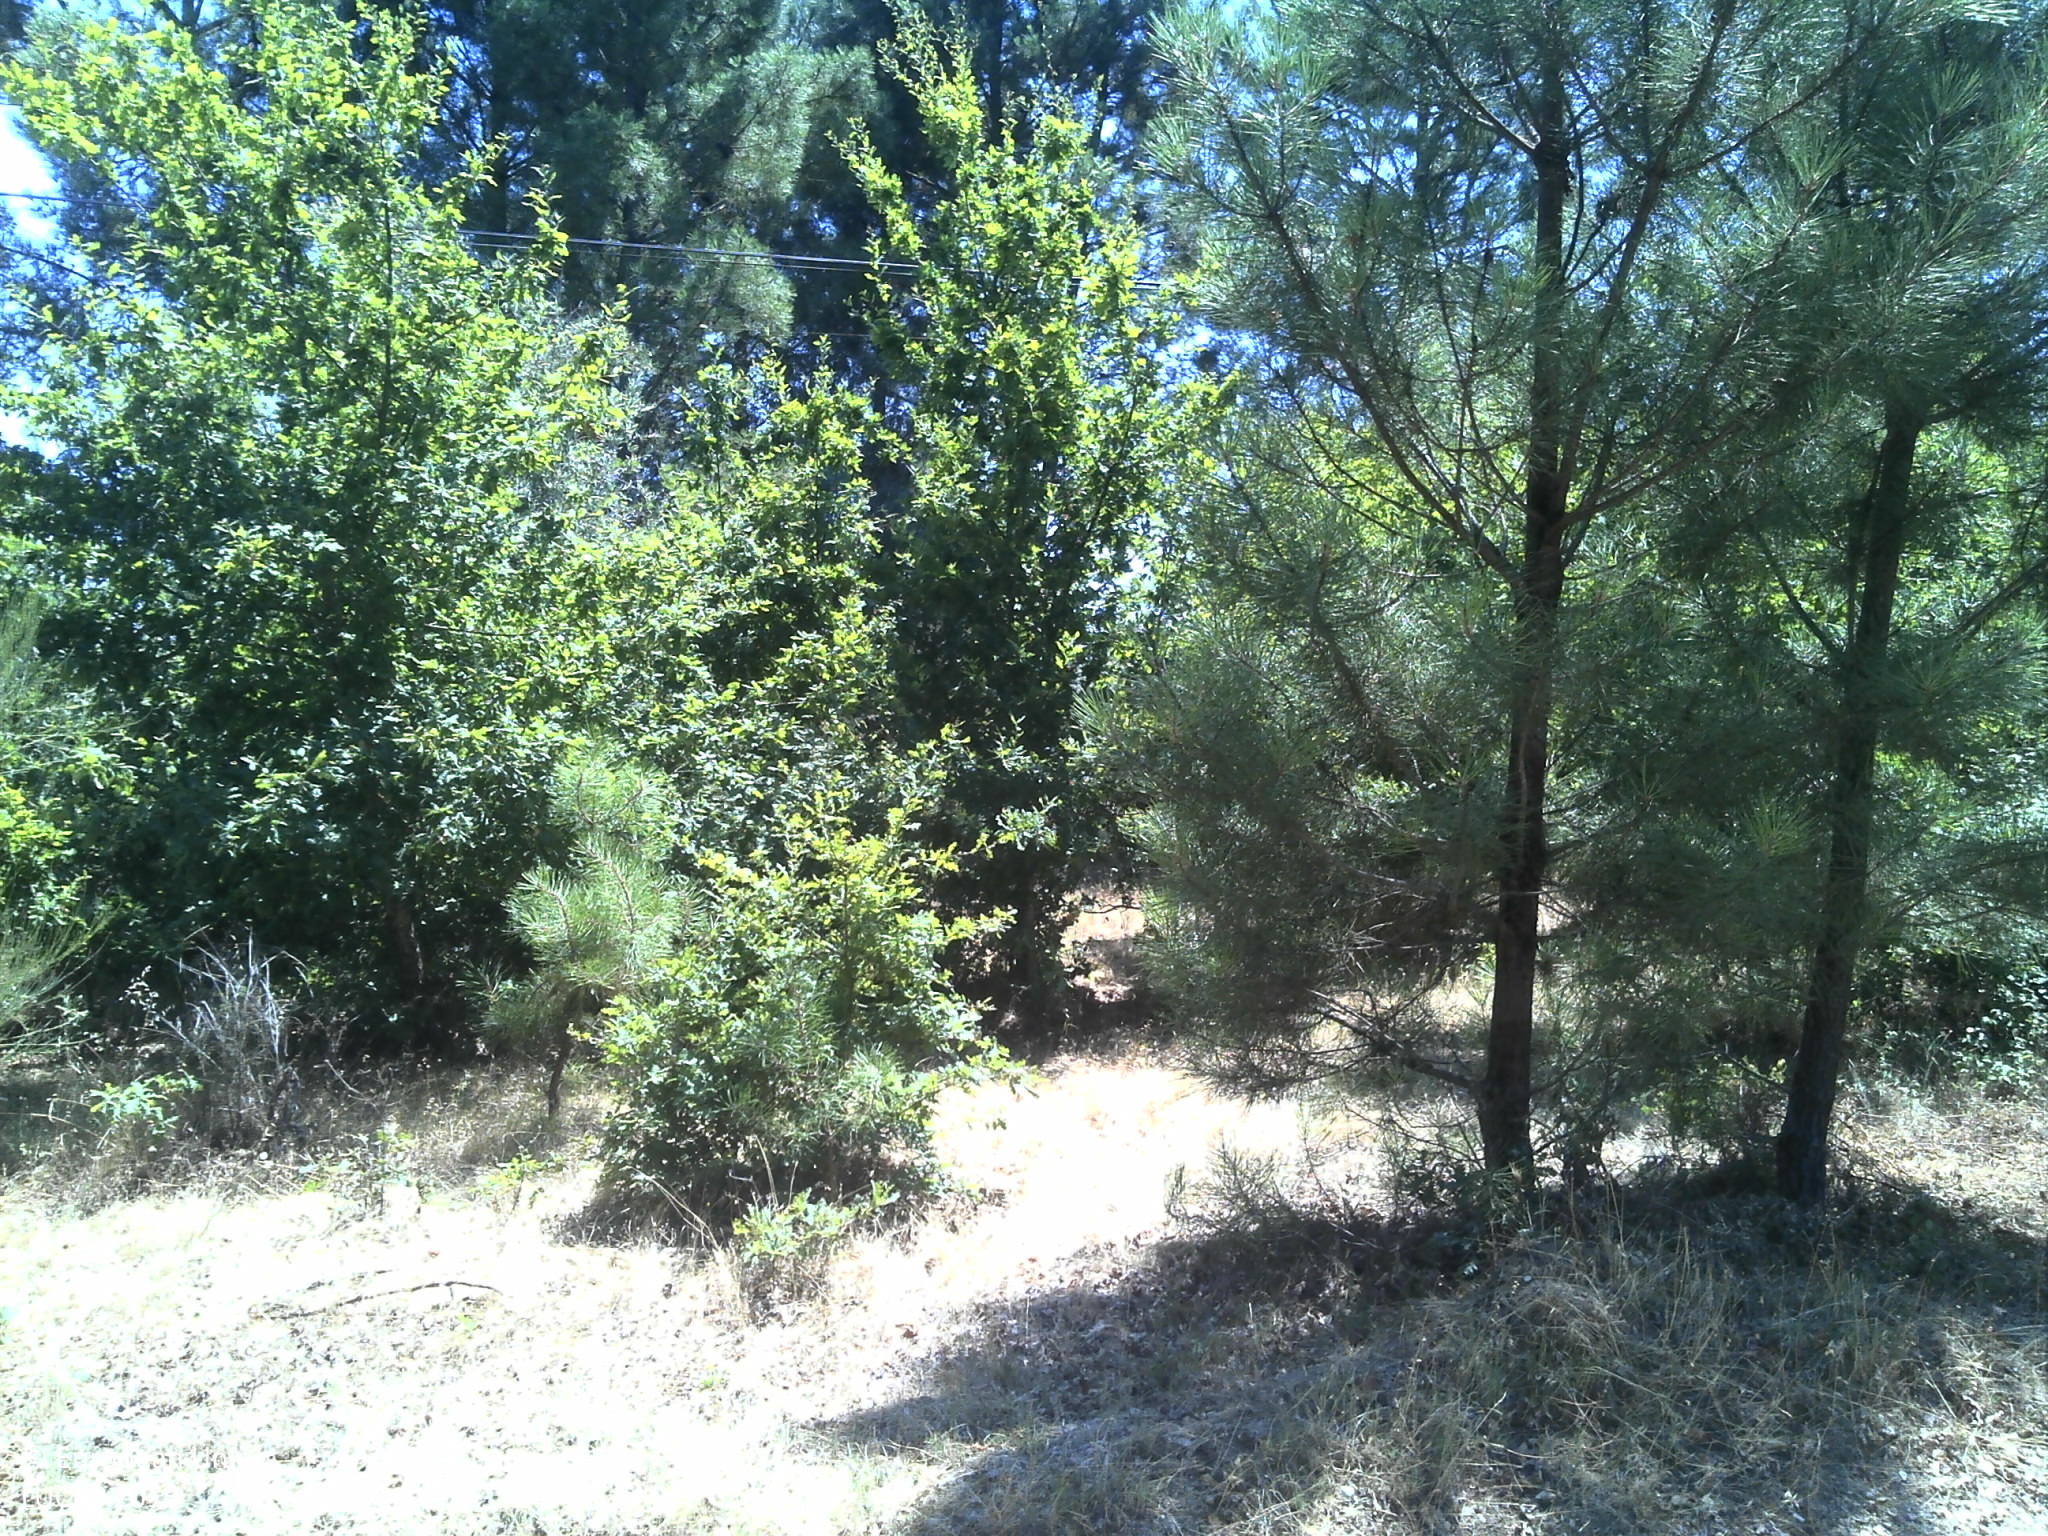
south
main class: Woodland
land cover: Broadleaved woodland
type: thermophilous deciduous forest
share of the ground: 50 - 75 %
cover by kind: broadleaved forest trees 70 %, shrubs 15 %, unconsolidated bare surface 15 %
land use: Forestry
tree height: > 5 m
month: July
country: PT
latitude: 40.3503
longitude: -7.9573
